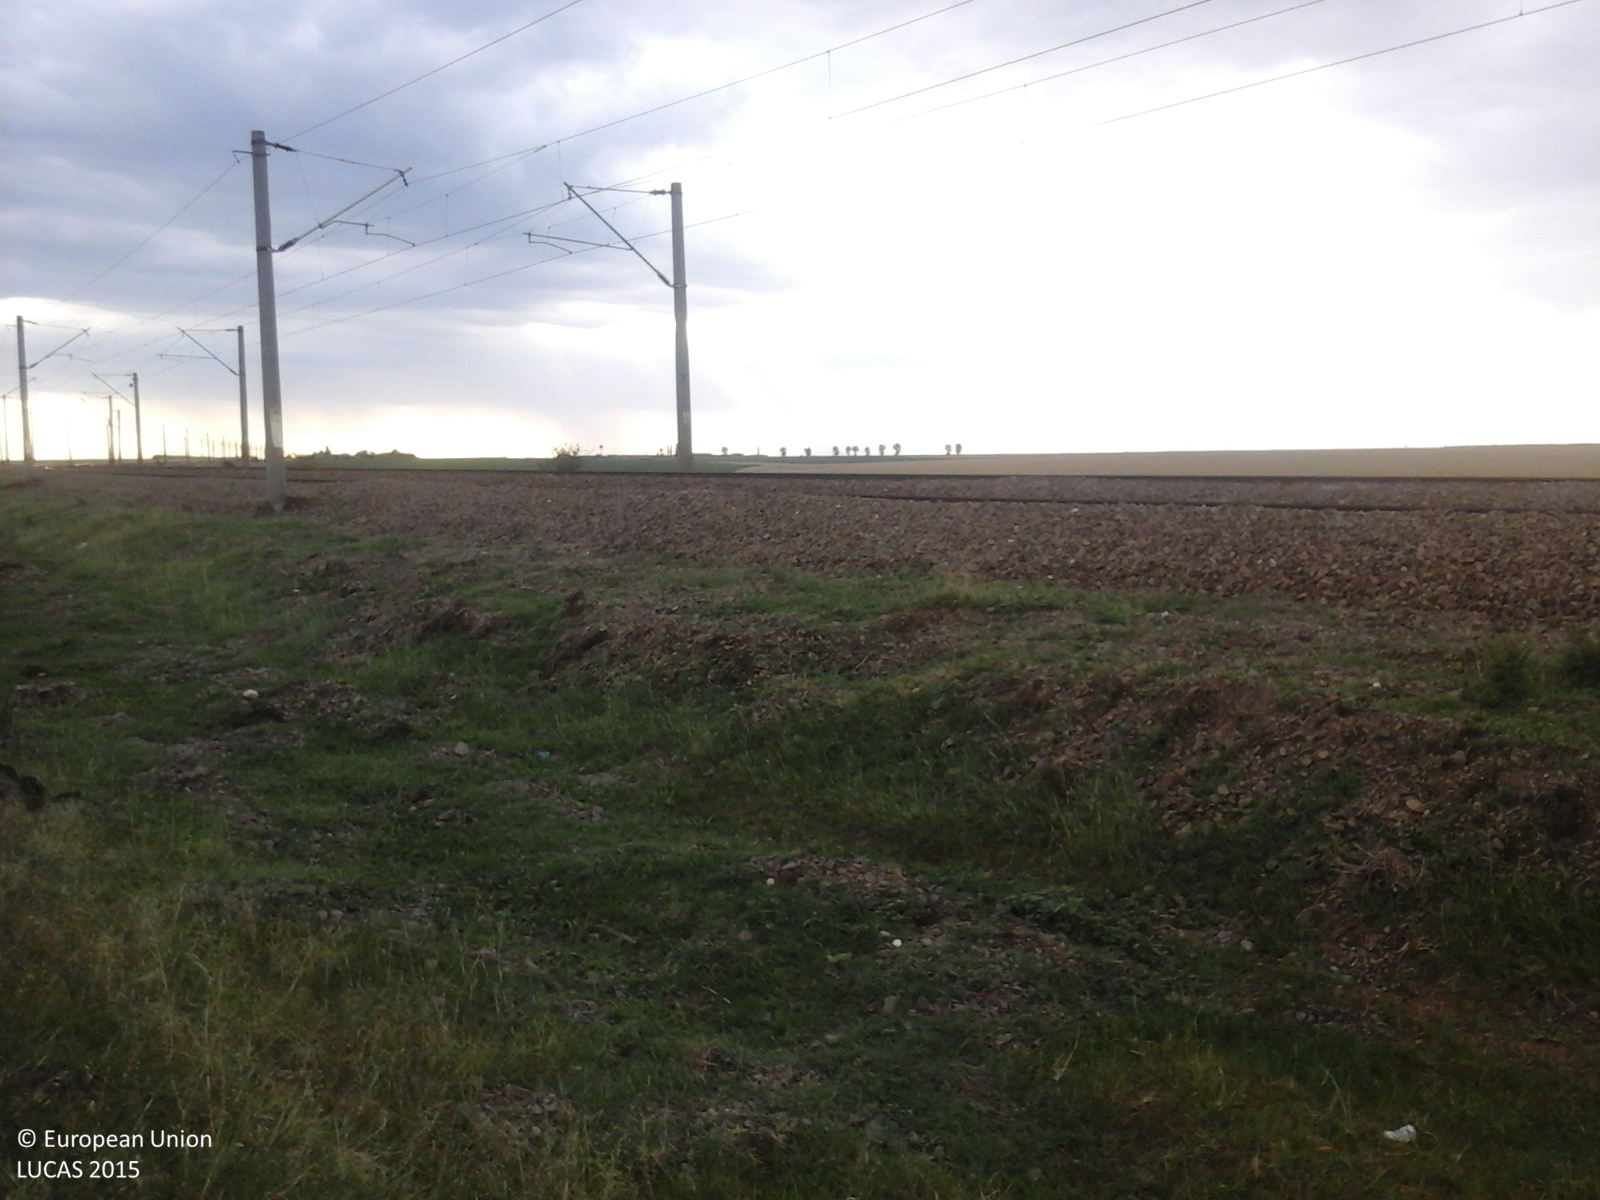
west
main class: Grassland
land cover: Grassland without tree/shrub cover
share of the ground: > 75 %
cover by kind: herbaceous plants 100 %
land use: Agriculture (excluding fallow land and kitchen gardens)
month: July
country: RO
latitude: 44.1094
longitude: 24.9056
